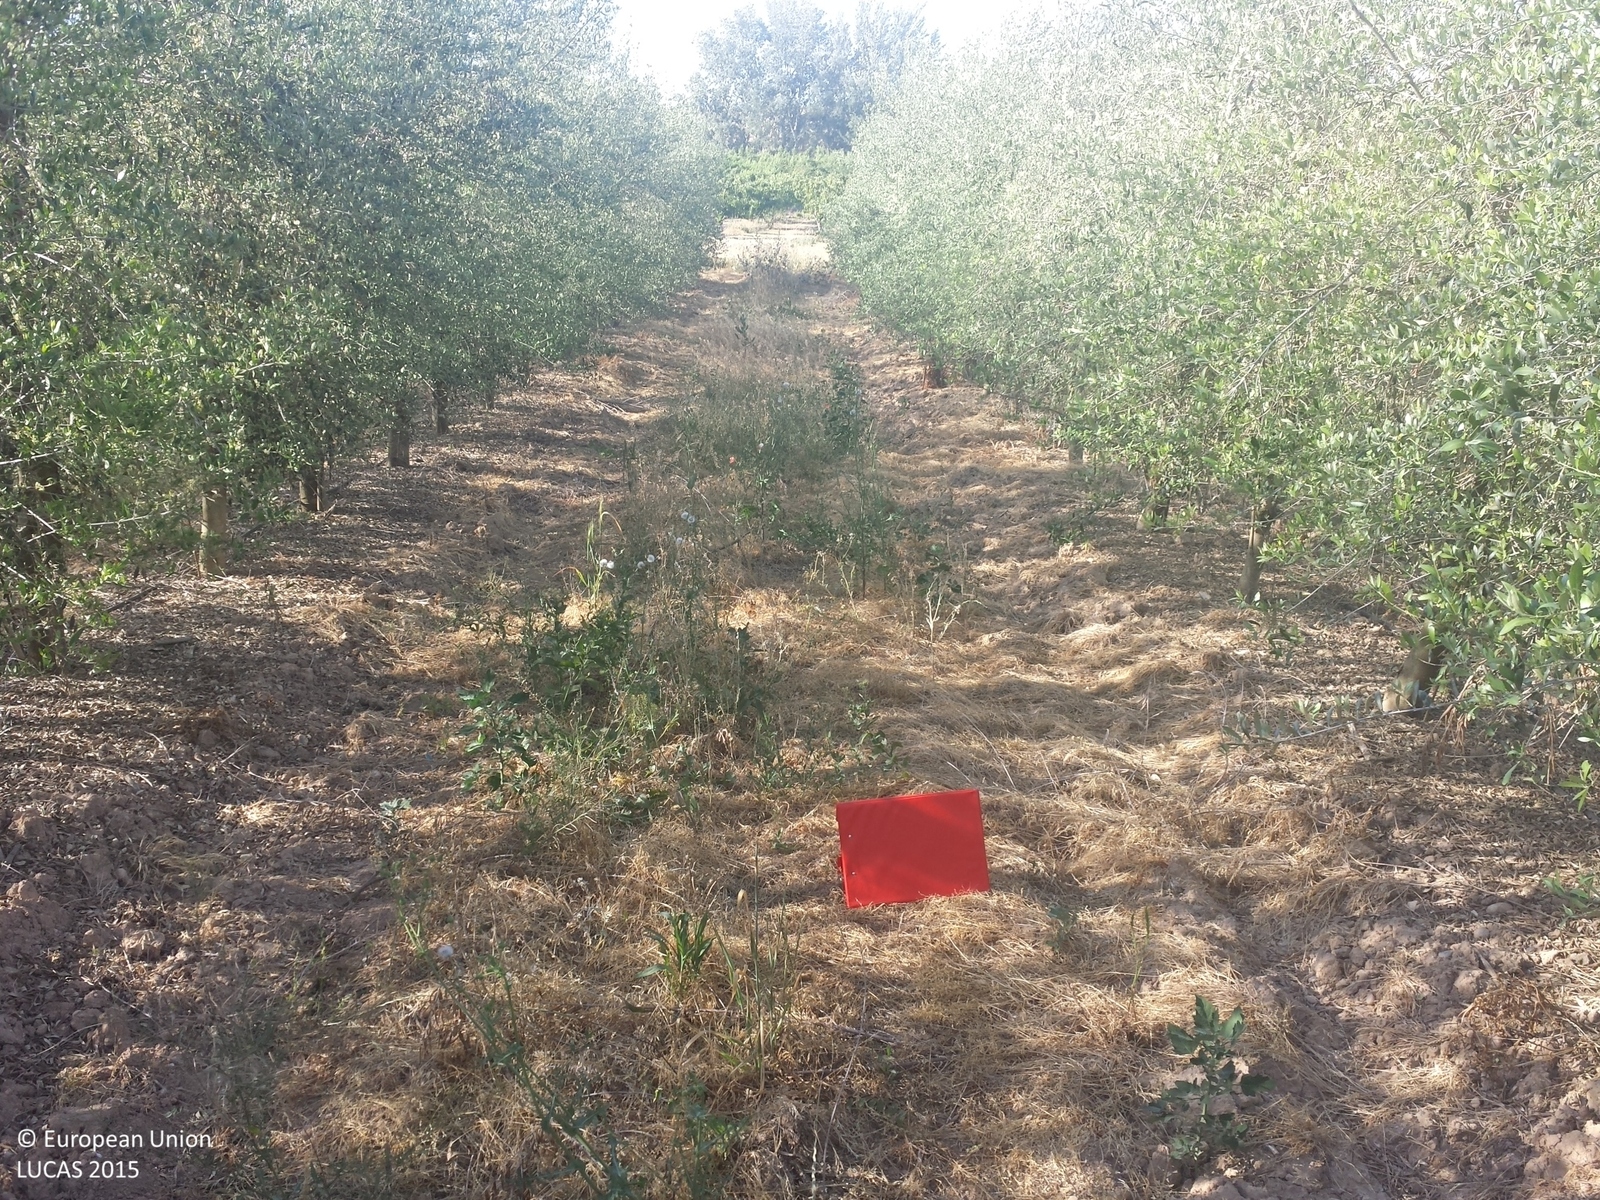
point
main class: Cropland
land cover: Olive groves
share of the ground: 25 - 50 %
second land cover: Grassland without tree/shrub cover
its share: > 75 %
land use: Agriculture (excluding fallow land and kitchen gardens)
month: May
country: ES
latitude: 41.6310
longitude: 0.5644
